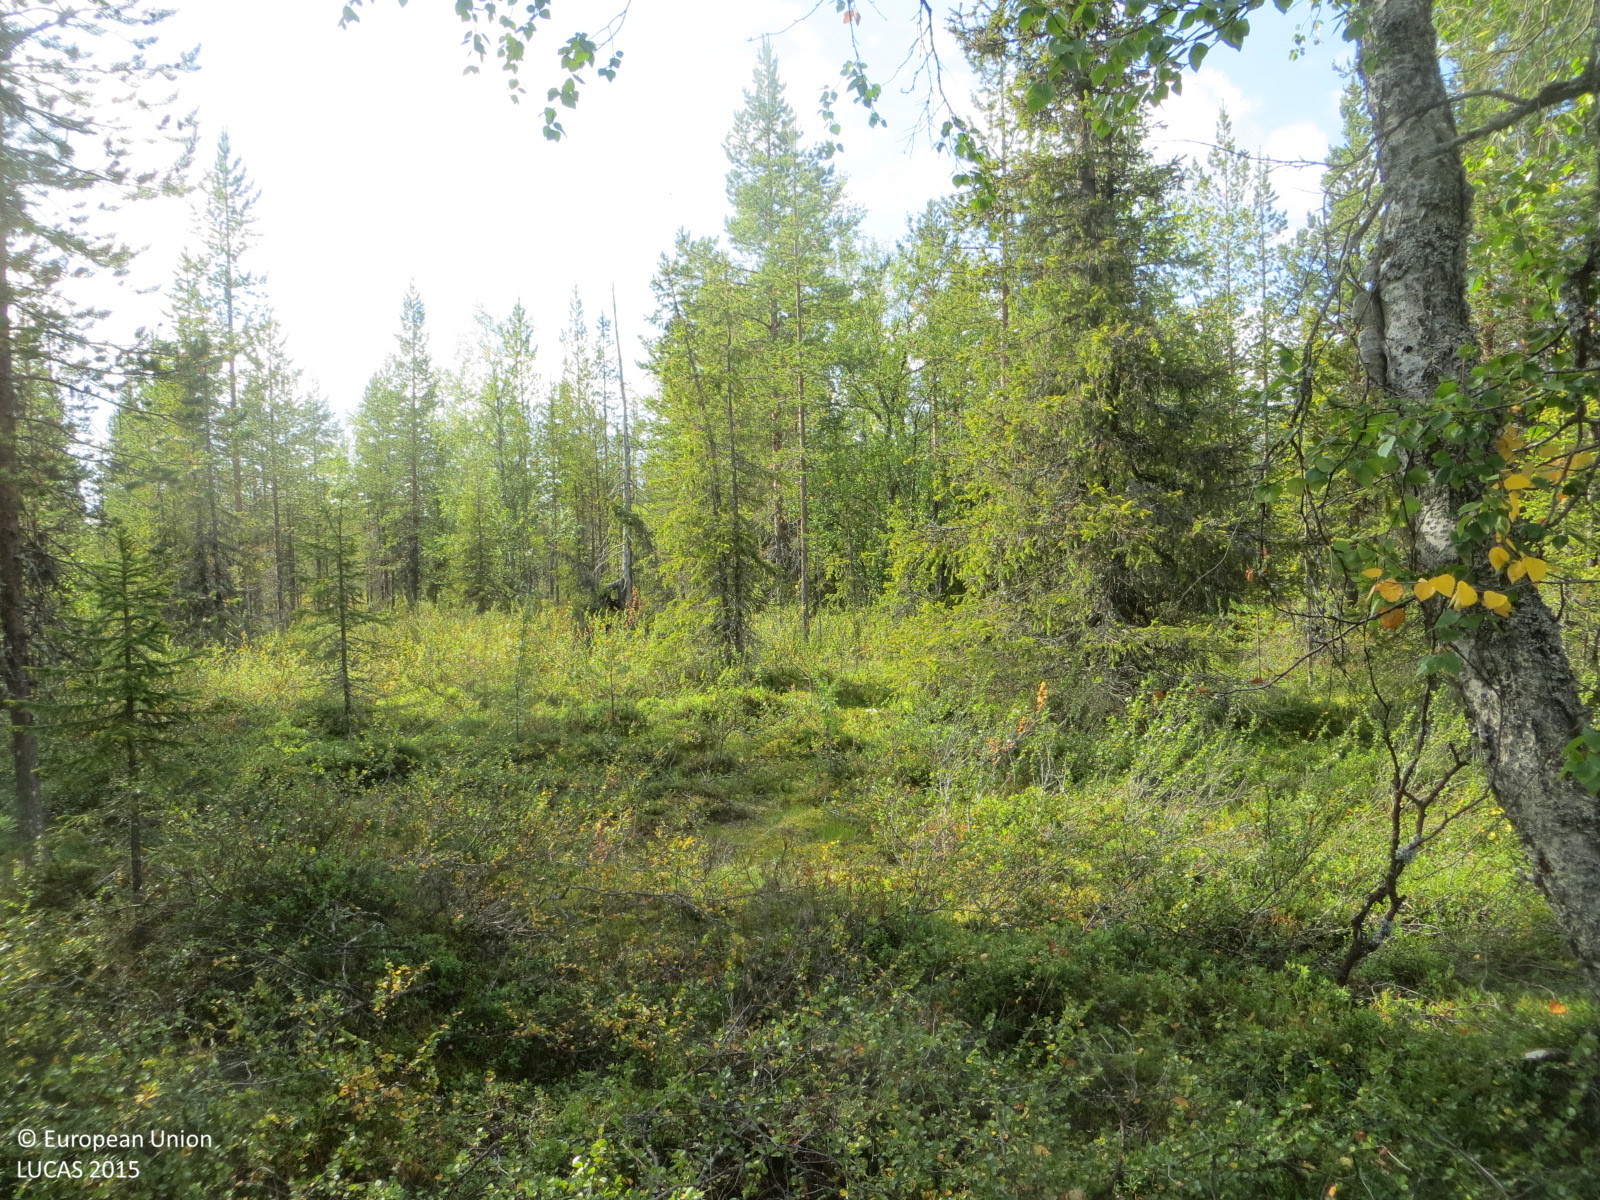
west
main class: Woodland
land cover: Pine dominated coniferous woodland
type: boreal forest
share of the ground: 50 - 75 %
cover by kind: coniferous forest trees 55 %, shrubs 35 %, broadleaved forest trees 10 %
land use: Forestry
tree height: > 5 m
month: August
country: FI
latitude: 67.9839
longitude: 25.5077
